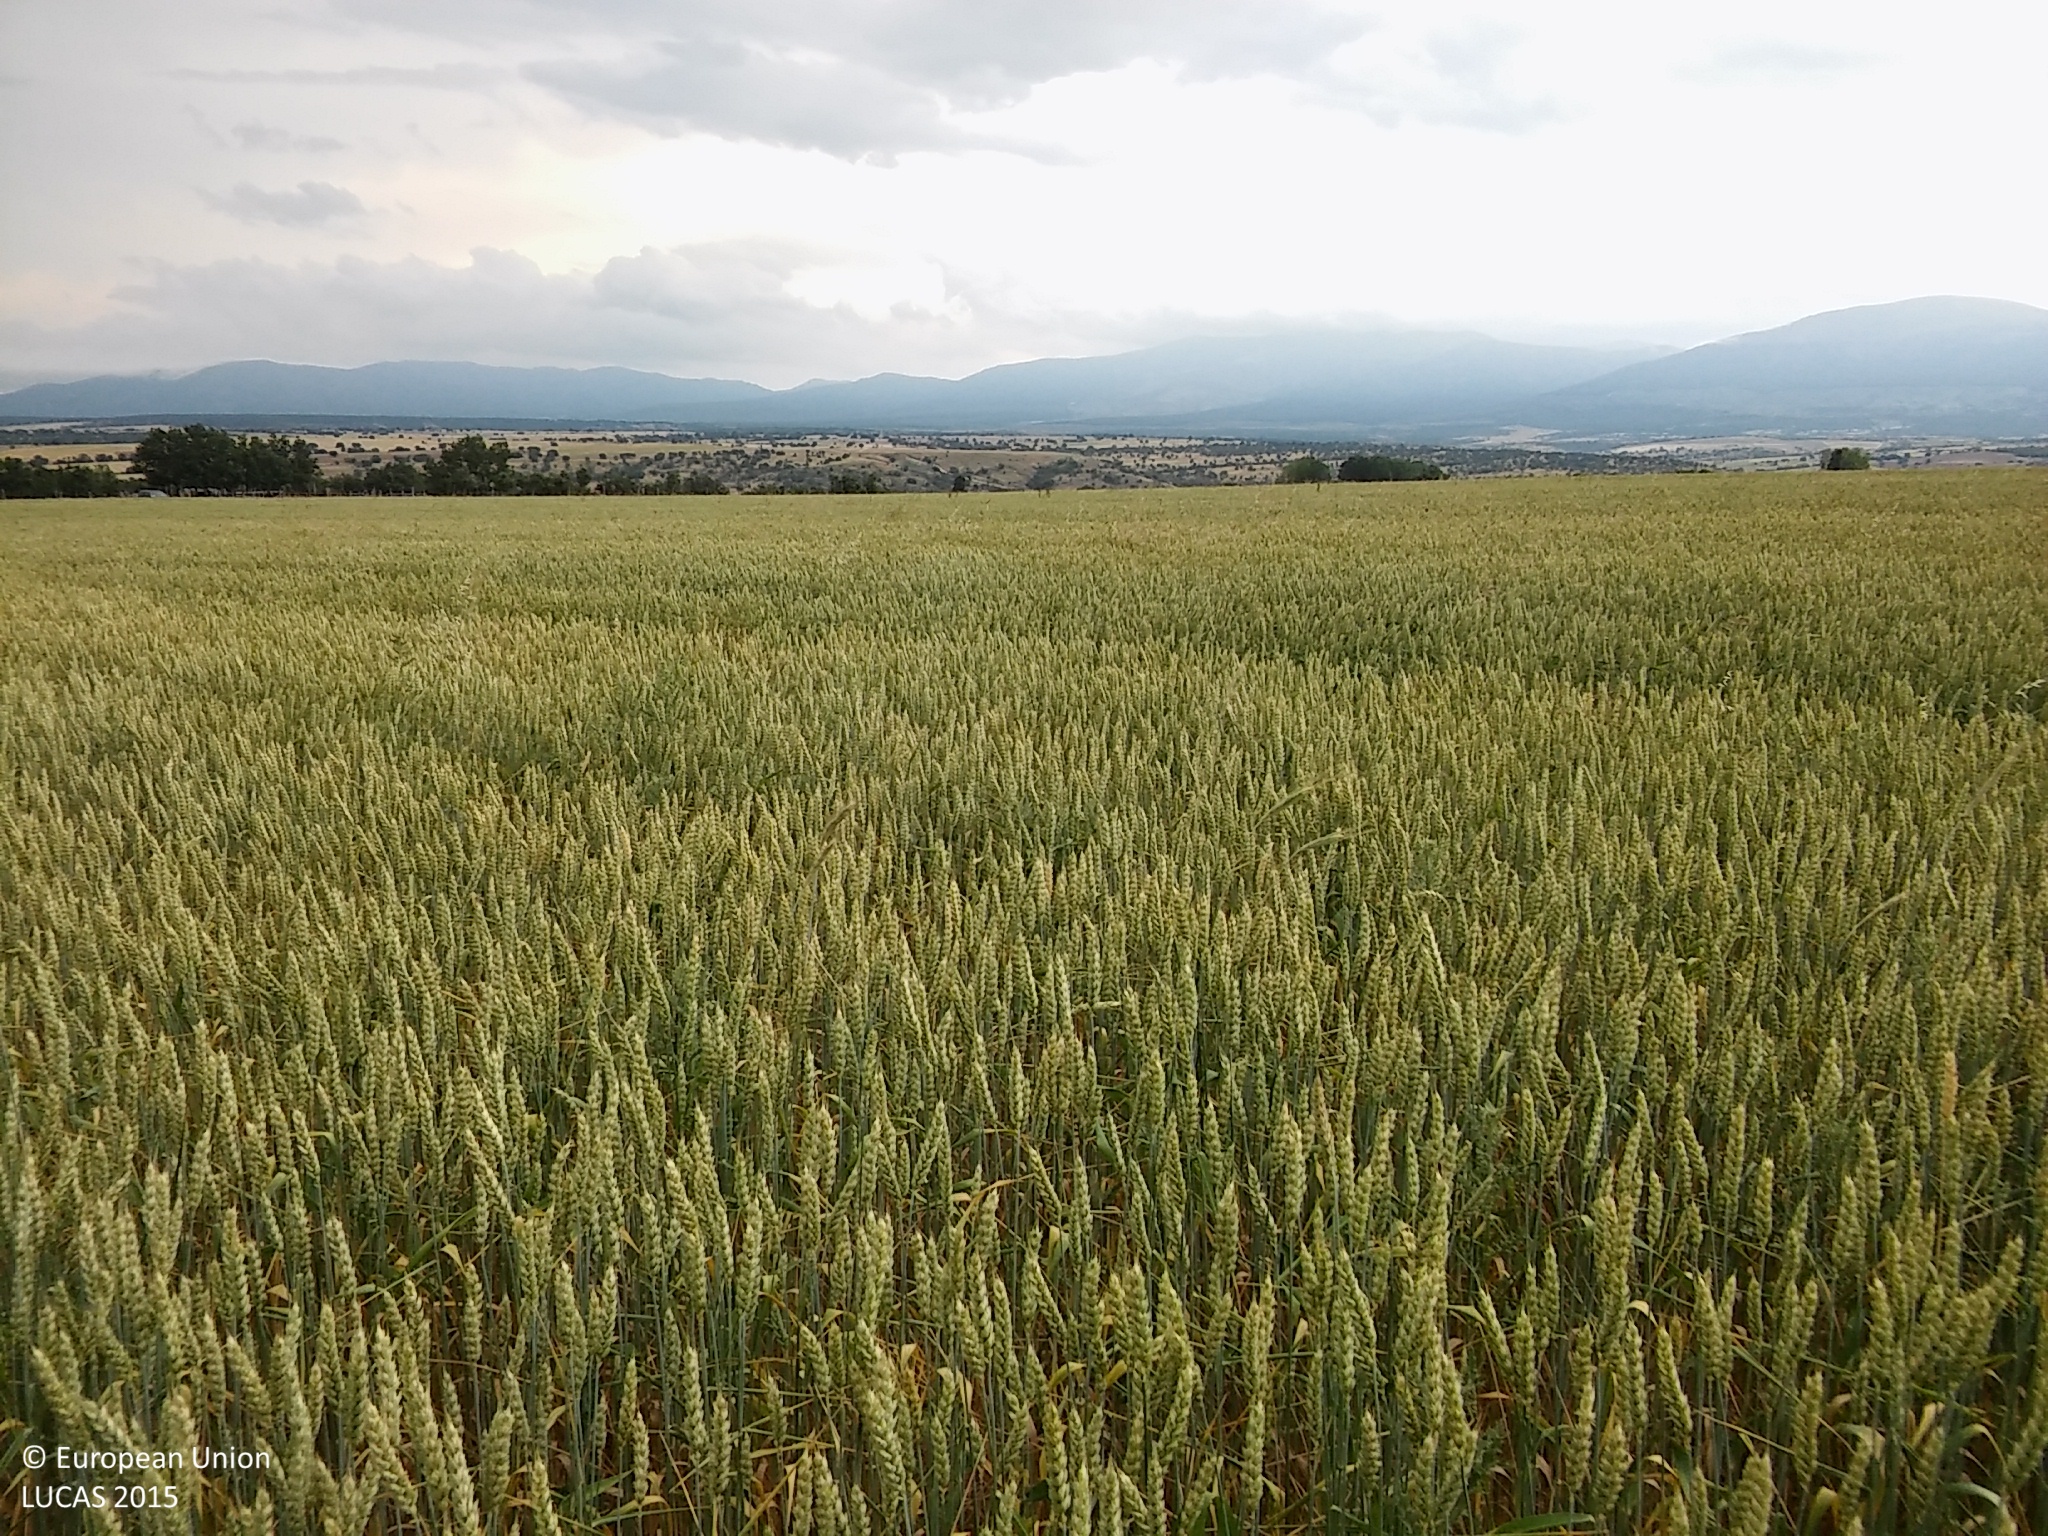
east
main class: Cropland
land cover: Common wheat
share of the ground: > 75 %
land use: Agriculture (excluding fallow land and kitchen gardens)
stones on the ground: 25 - 50 %
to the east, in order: Common wheat; Grass margins; Ditches and canals; Grass margins; Paved roads, cycling and walking lanes; Grass margins; Fences; Grassland with sparse tree/shrub cover; Broadleaved woodland
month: June
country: ES
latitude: 41.2475
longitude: -3.6632
